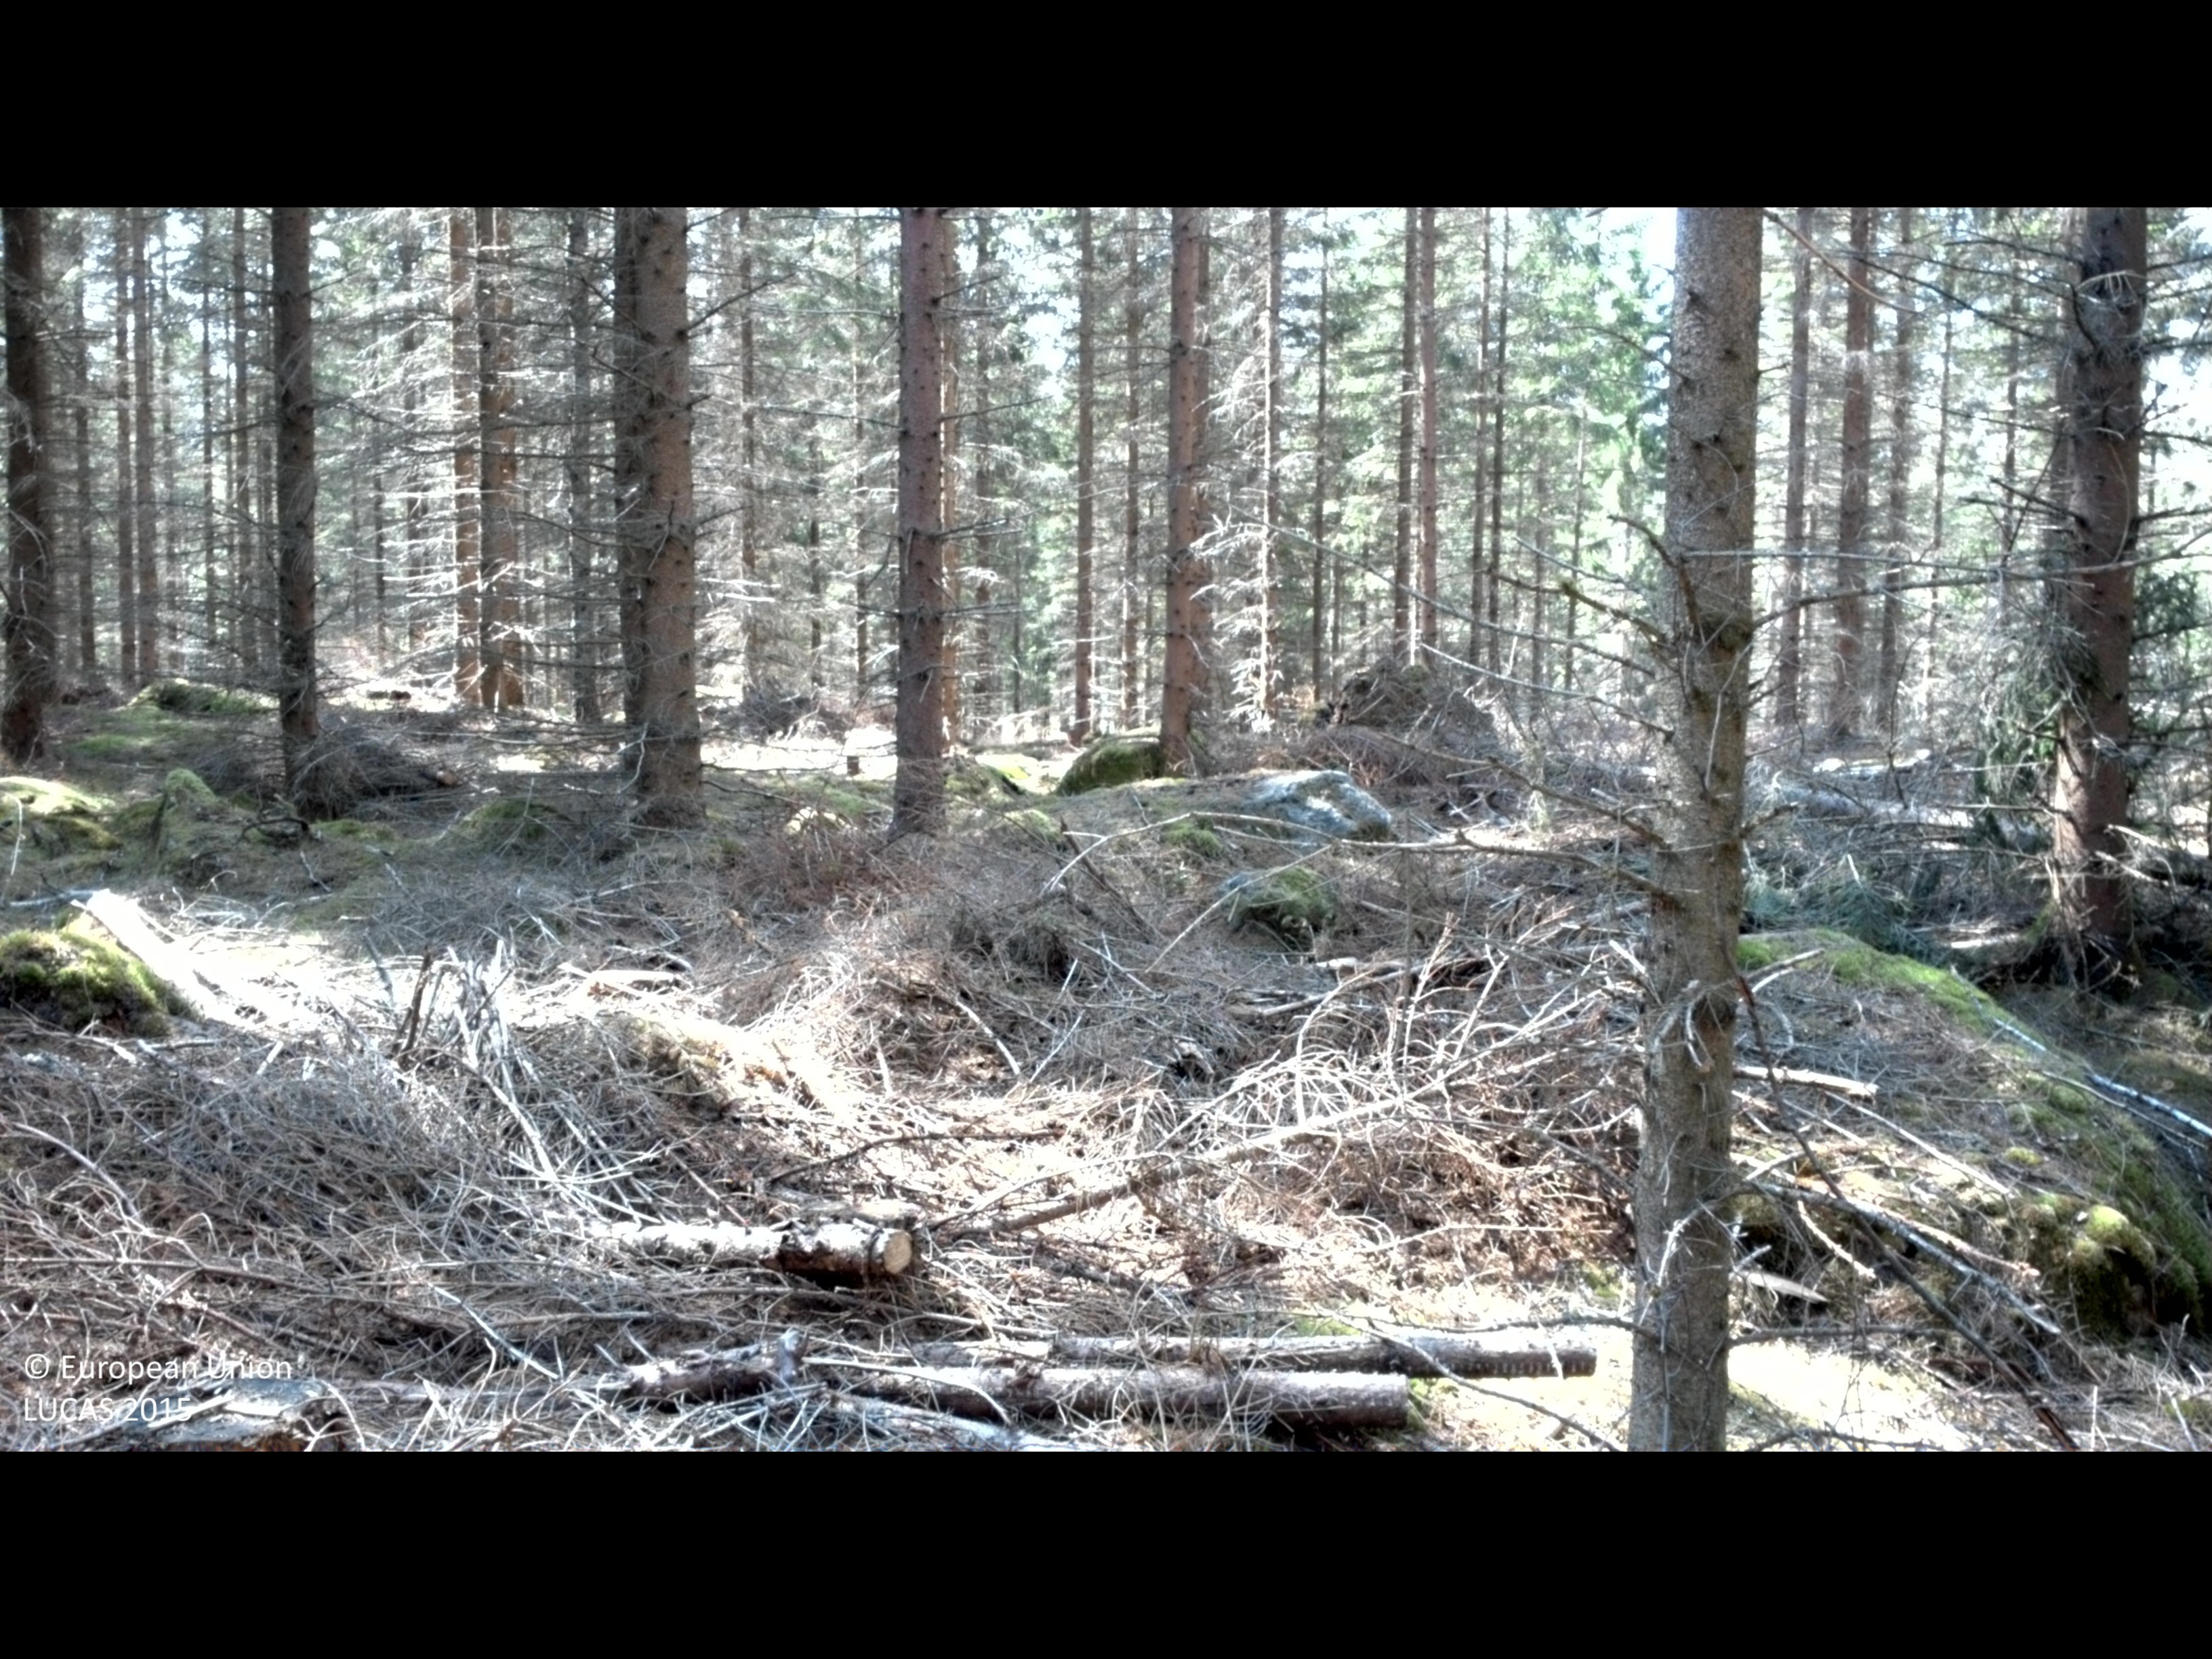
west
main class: Woodland
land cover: Spruce dominated coniferous woodland
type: boreal forest
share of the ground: 50 - 75 %
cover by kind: coniferous forest trees 65 %, lichens and mosses 20 %, unconsolidated bare surface 10 %, broadleaved forest trees 5 %
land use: Forestry
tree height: > 5 m
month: July
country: SE
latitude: 56.4411
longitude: 14.2633
